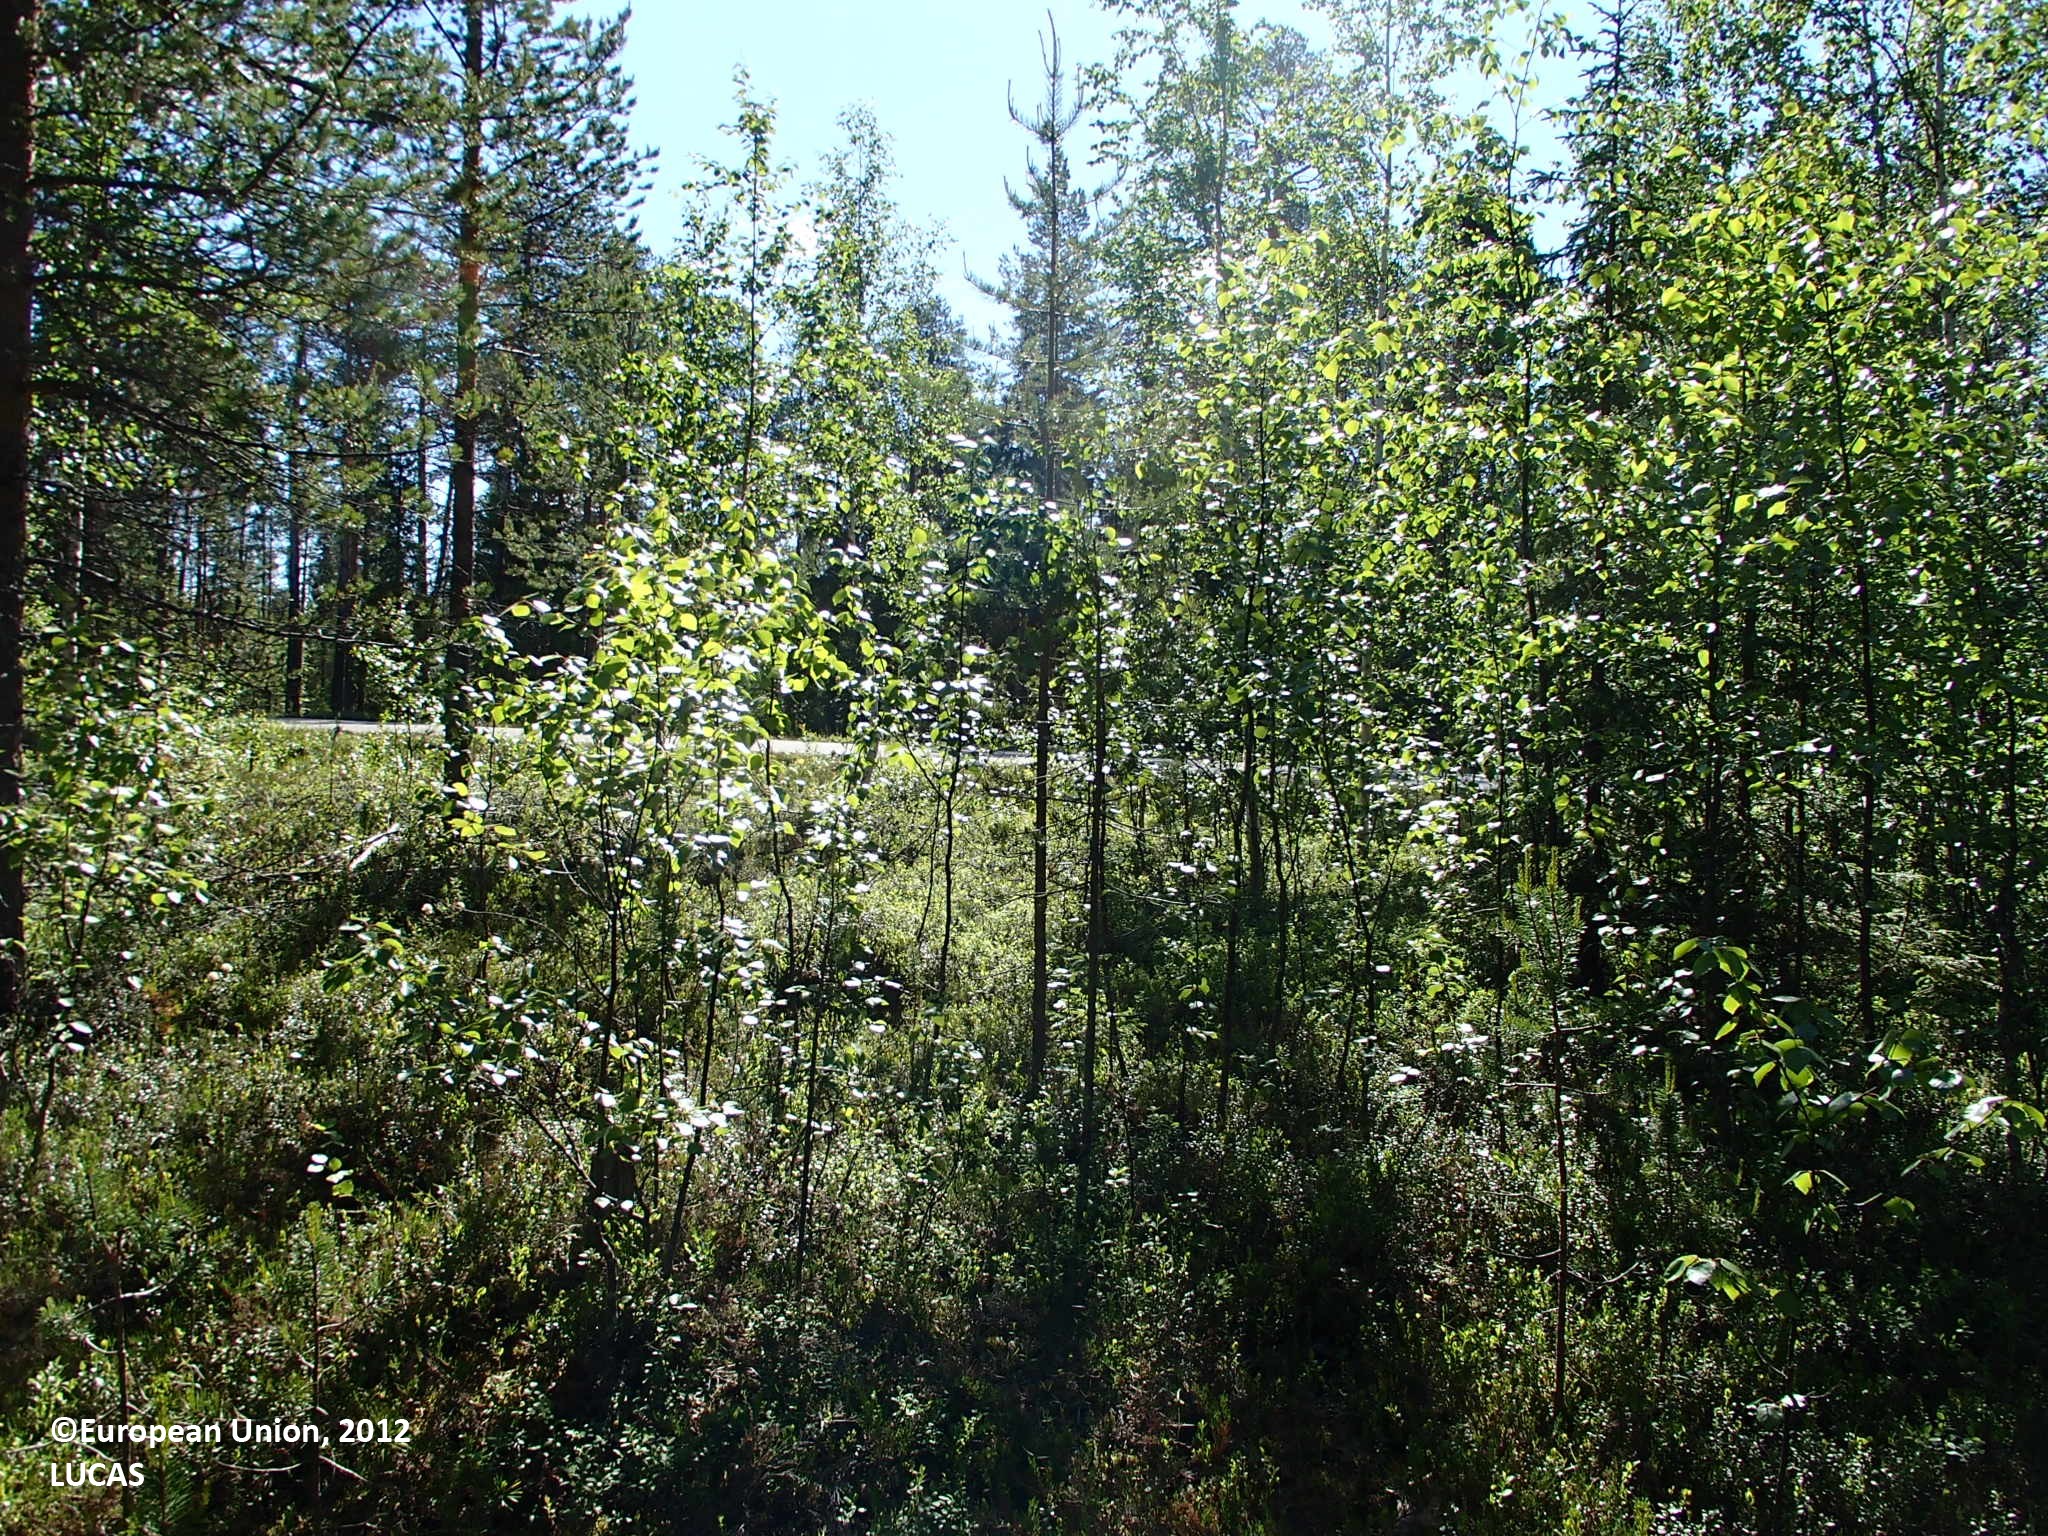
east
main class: Woodland
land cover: Other mixed woodland
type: boreal forest
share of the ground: > 75 %
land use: Forestry
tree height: > 5 m
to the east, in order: Other mixed woodland; Grassland without tree/shrub cover; Paved roads, cycling and walking lanes; Grassland without tree/shrub cover; Other mixed woodland
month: July
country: FI
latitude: 67.2045
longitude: 27.8054
